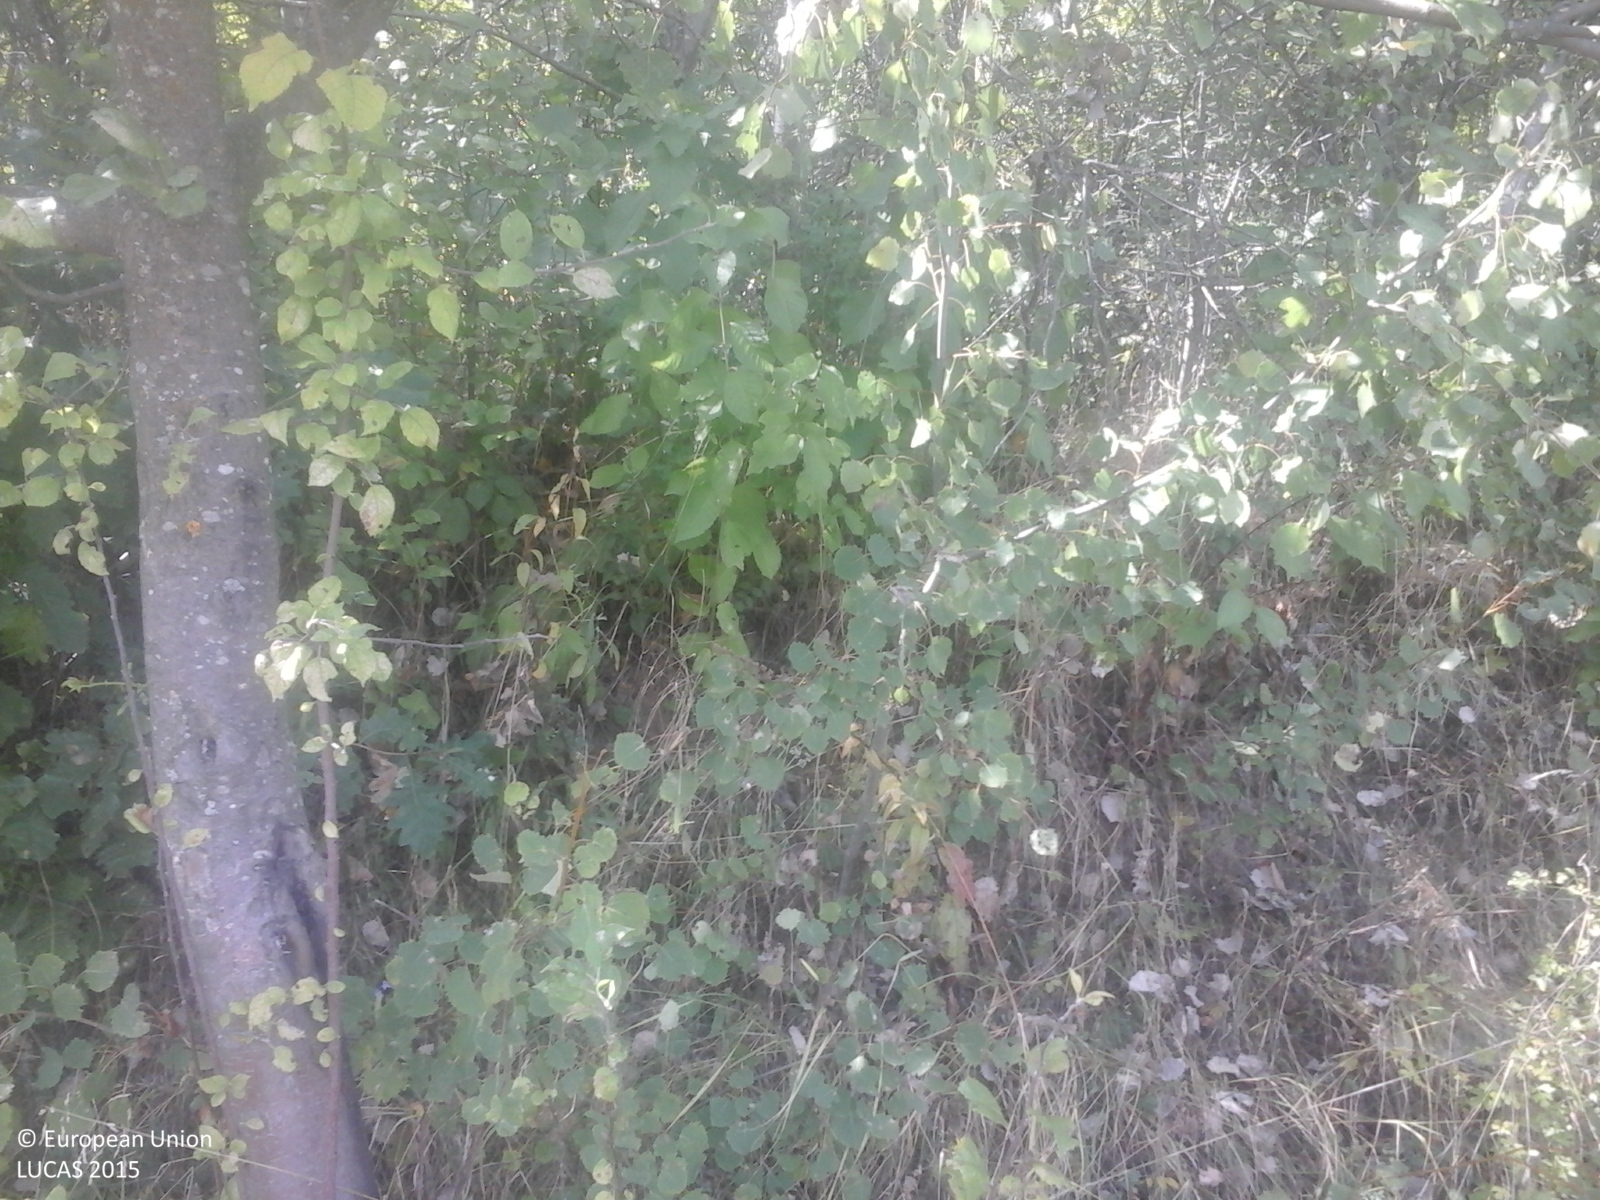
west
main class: Woodland
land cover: Broadleaved woodland
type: acidophilous oak and oak-birch forest
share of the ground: > 75 %
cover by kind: broadleaved forest trees 100 %
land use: Forestry
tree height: > 5 m
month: September
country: RO
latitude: 46.9108
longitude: 23.2344
